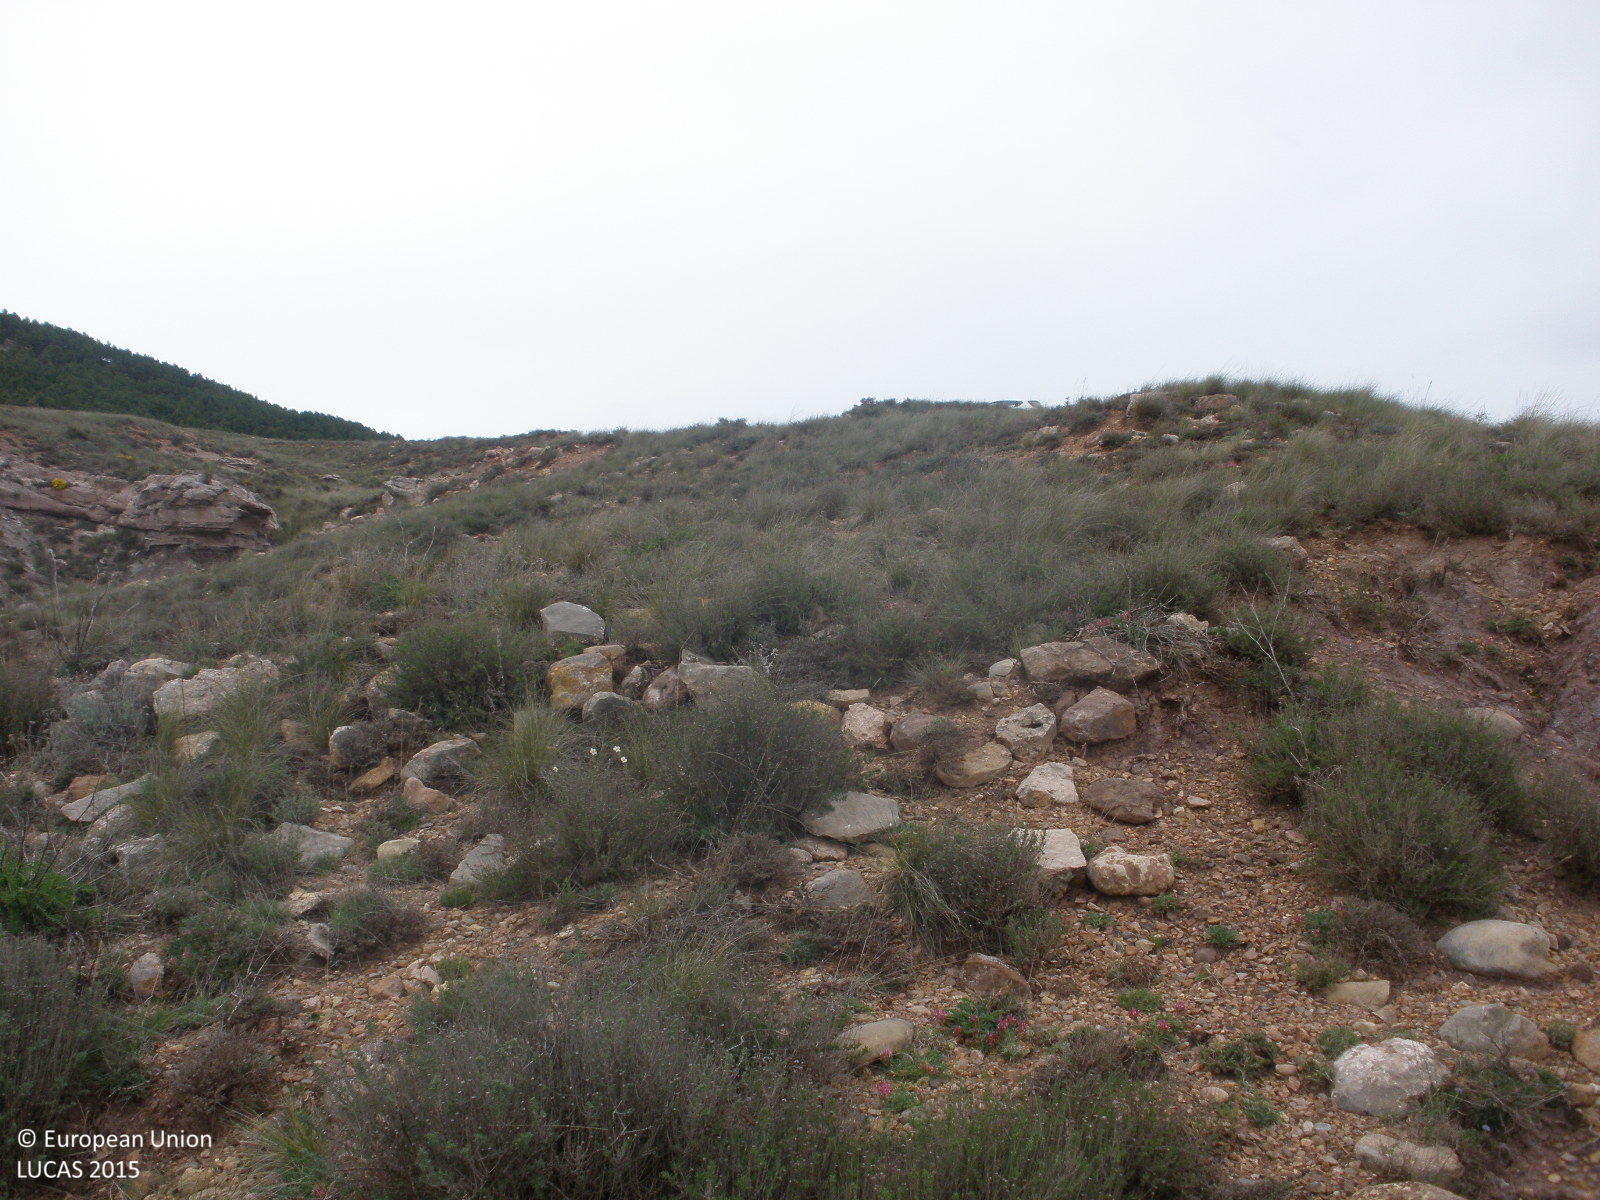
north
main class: Shrubland
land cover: Shrubland without tree cover
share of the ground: 25 - 50 %
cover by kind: consolidated bare surface 50 %, shrubs 30 %, herbaceous plants 20 %
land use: Semi-natural and natural areas not in use
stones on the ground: 10 - 25 %
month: May
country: ES
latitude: 40.5609
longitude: -0.8175
